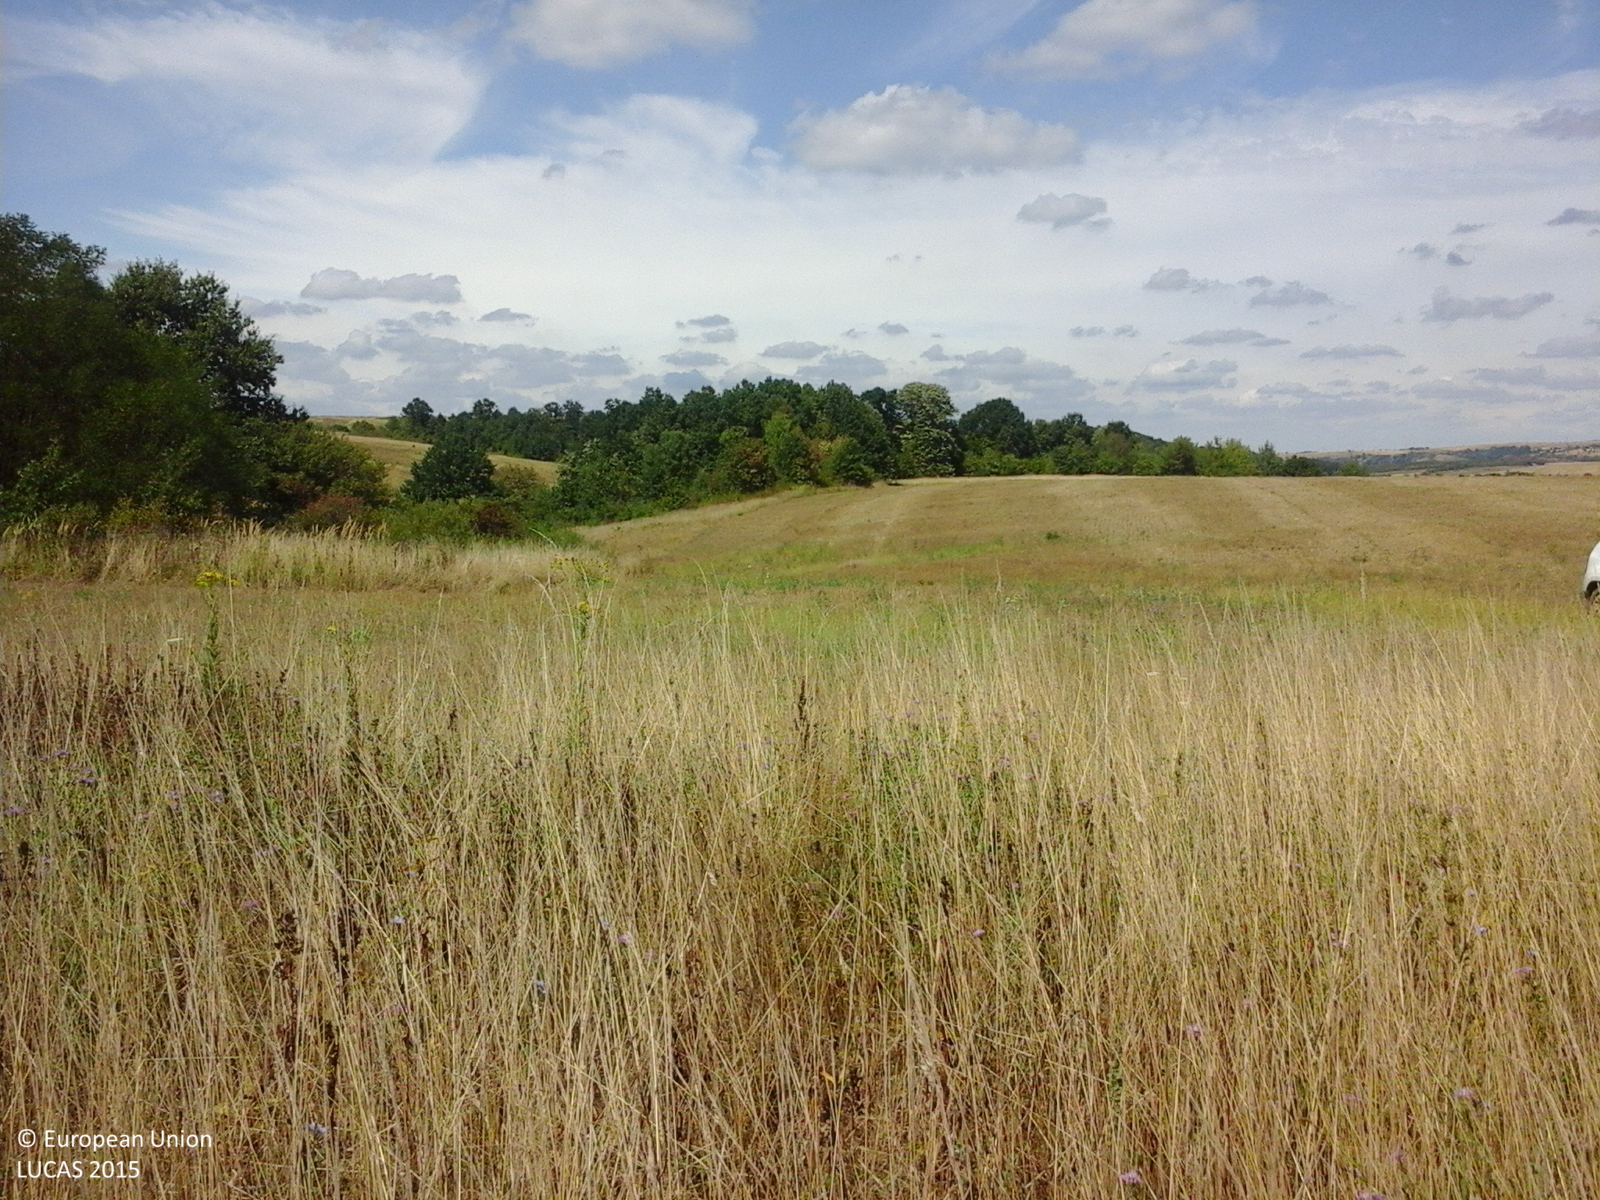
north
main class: Grassland
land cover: Spontaneously vegetated surfaces
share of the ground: > 75 %
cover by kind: herbaceous plants 100 %
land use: Agriculture (excluding fallow land and kitchen gardens)
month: August
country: RO
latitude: 45.3472
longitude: 21.6605
